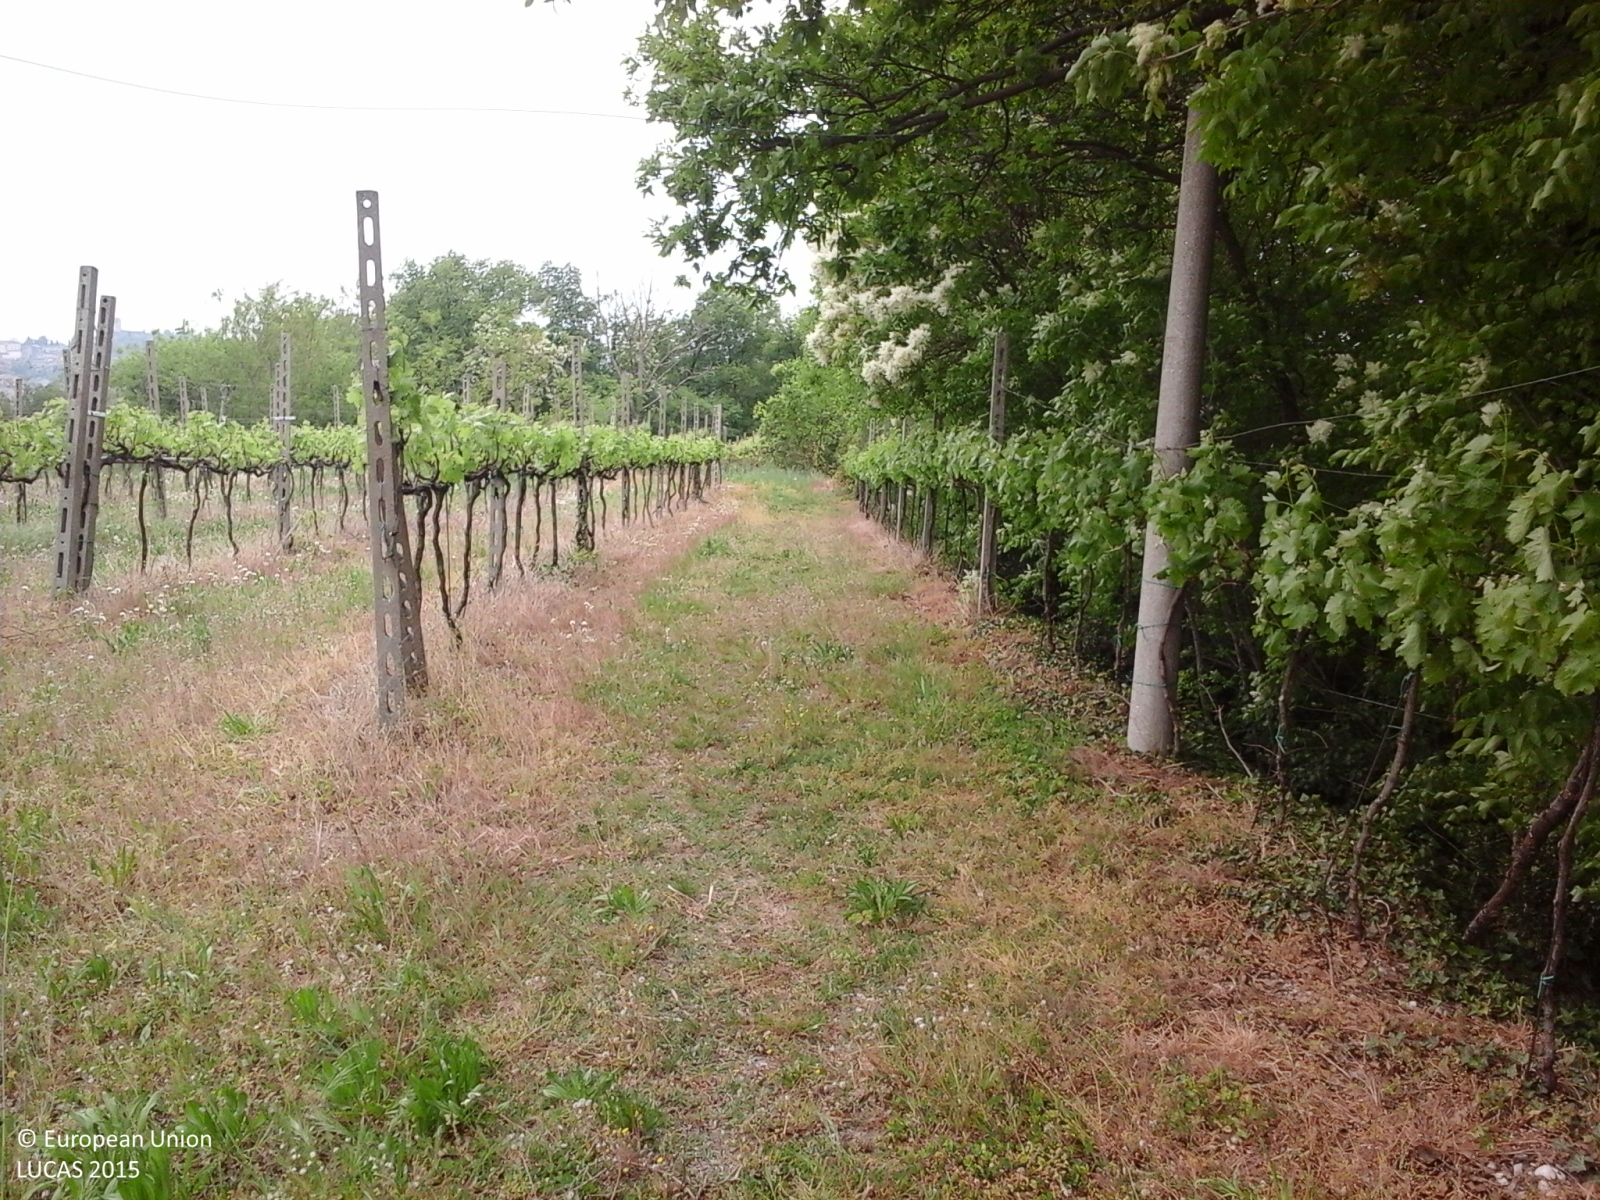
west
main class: Woodland
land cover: Broadleaved woodland
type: mesophytic deciduous forest
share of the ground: > 75 %
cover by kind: broadleaved forest trees 100 %
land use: Semi-natural and natural areas not in use
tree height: > 5 m
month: April
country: IT
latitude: 45.3584
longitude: 10.6244
